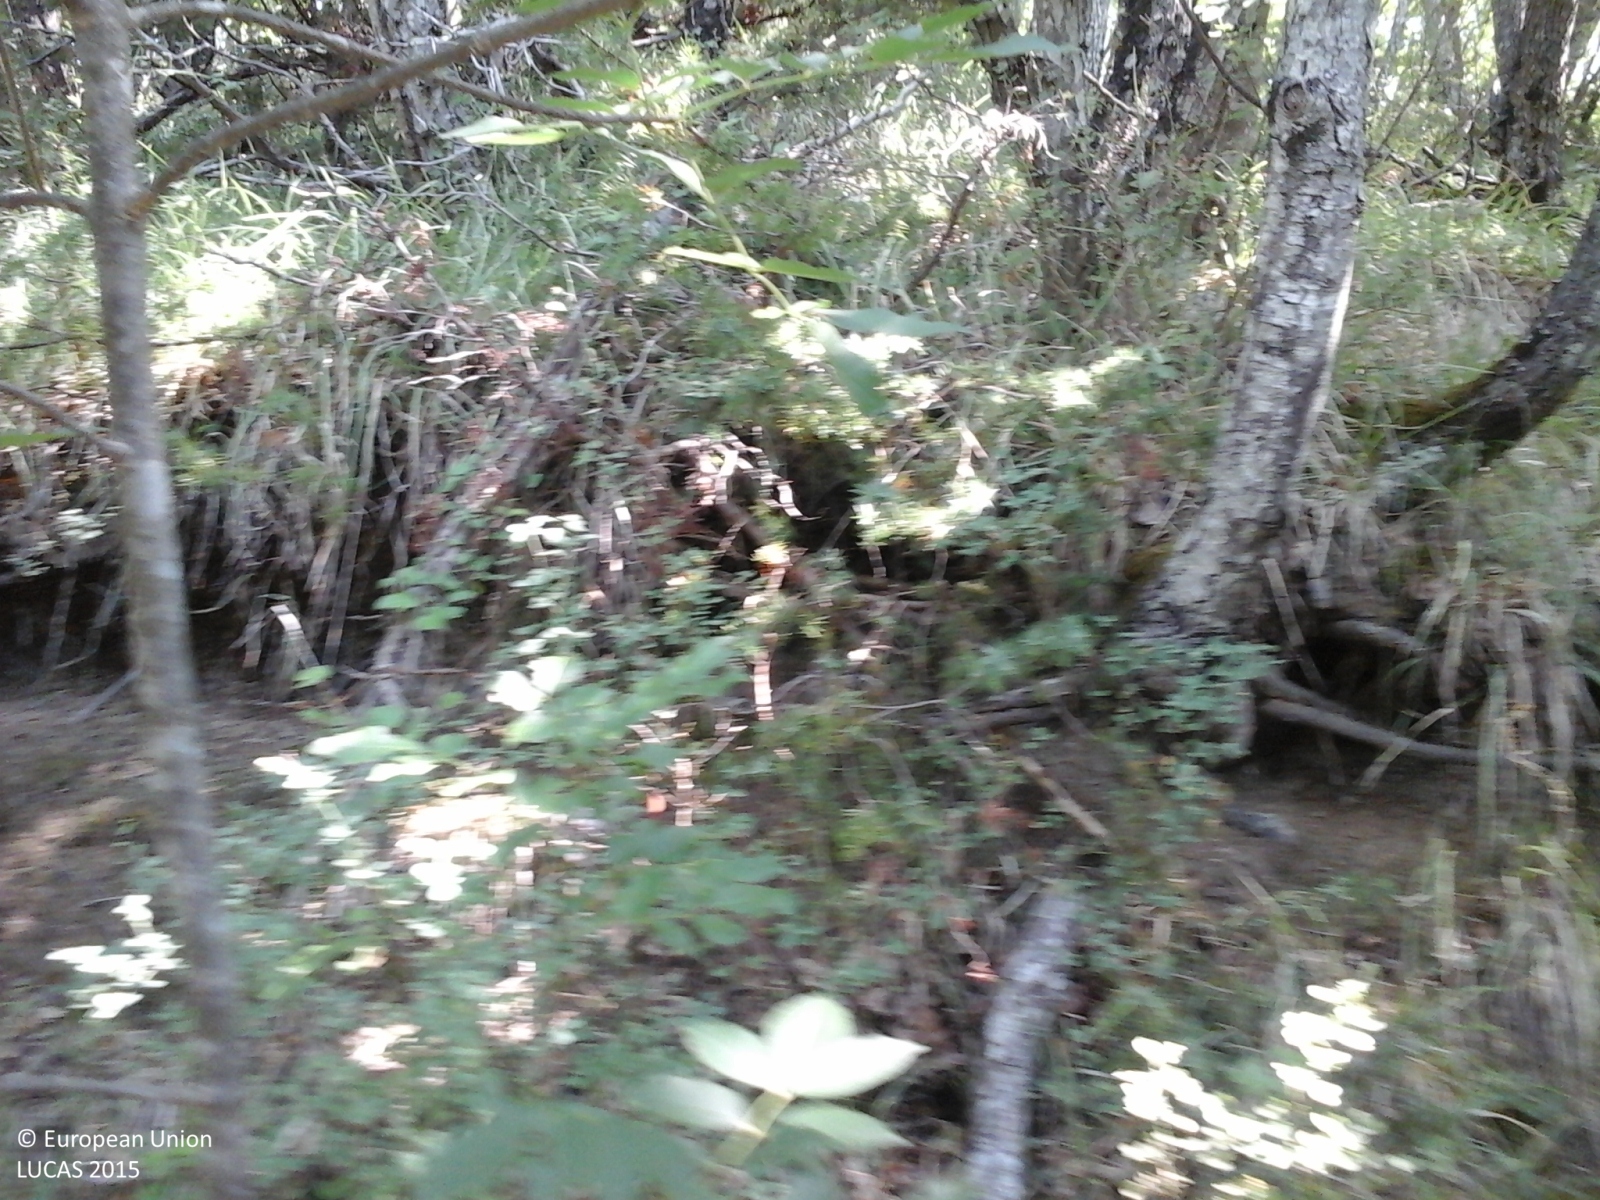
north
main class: Woodland
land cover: Broadleaved woodland
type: thermophilous deciduous forest
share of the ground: > 75 %
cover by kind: broadleaved forest trees 100 %
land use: Forestry
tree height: > 5 m
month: August
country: IT
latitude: 43.6953
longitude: 12.2153
